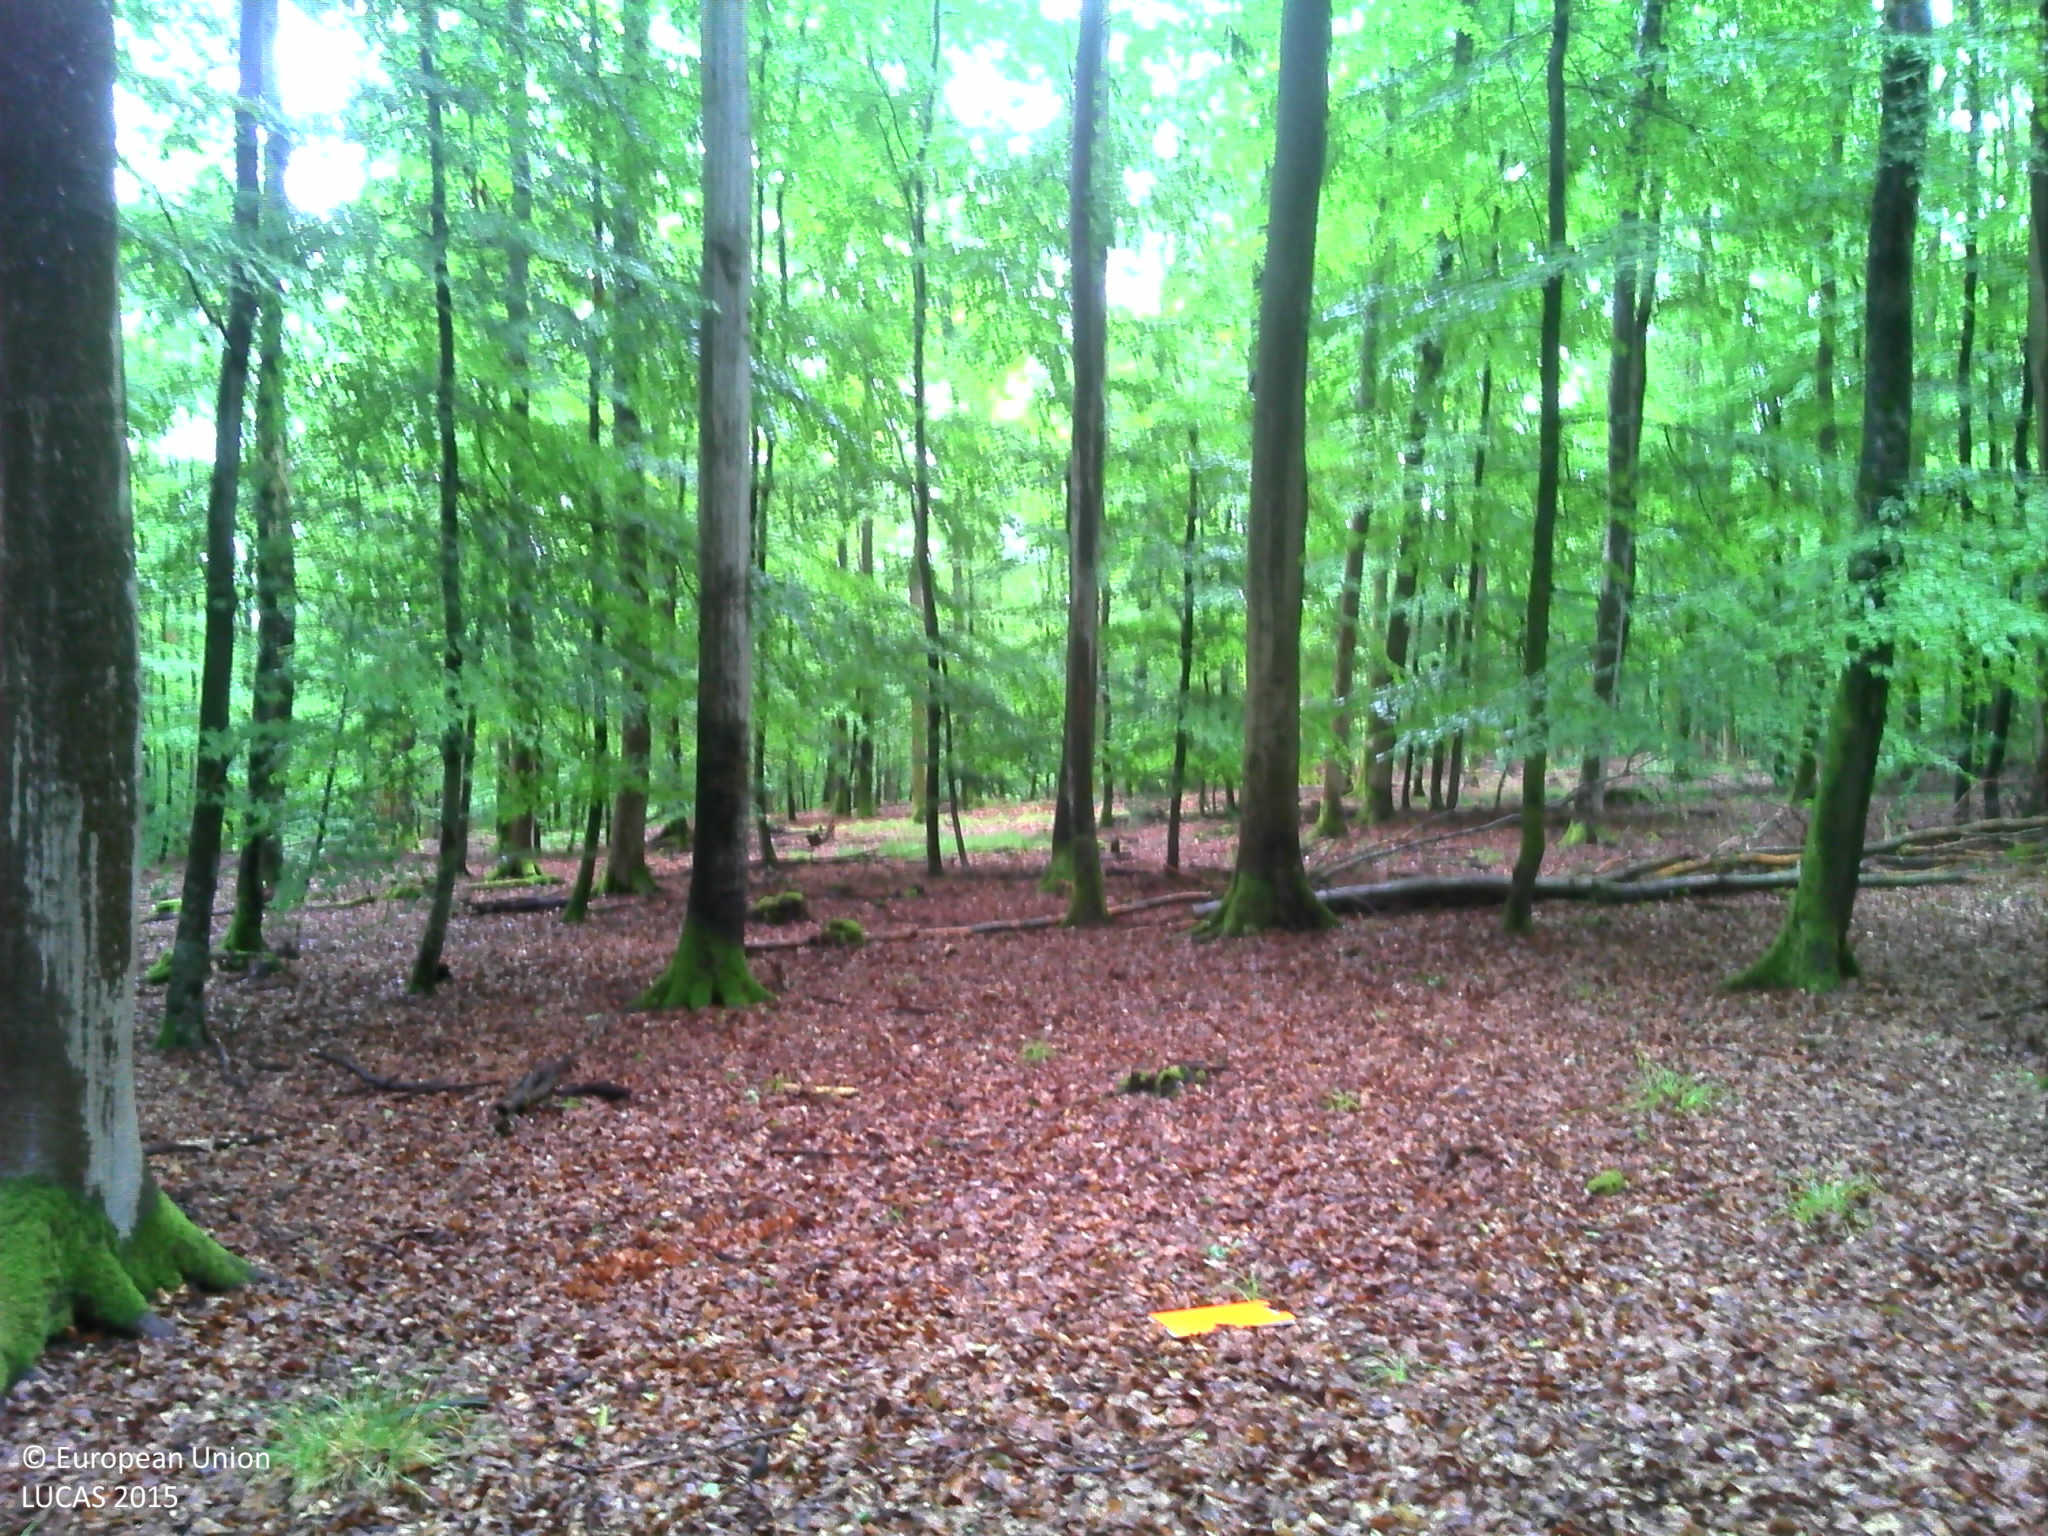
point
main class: Woodland
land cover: Broadleaved woodland
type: beech forest
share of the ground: > 75 %
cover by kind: broadleaved forest trees 100 %
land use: Forestry
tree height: > 5 m
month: July
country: FR
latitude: 48.9455
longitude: 7.2561
